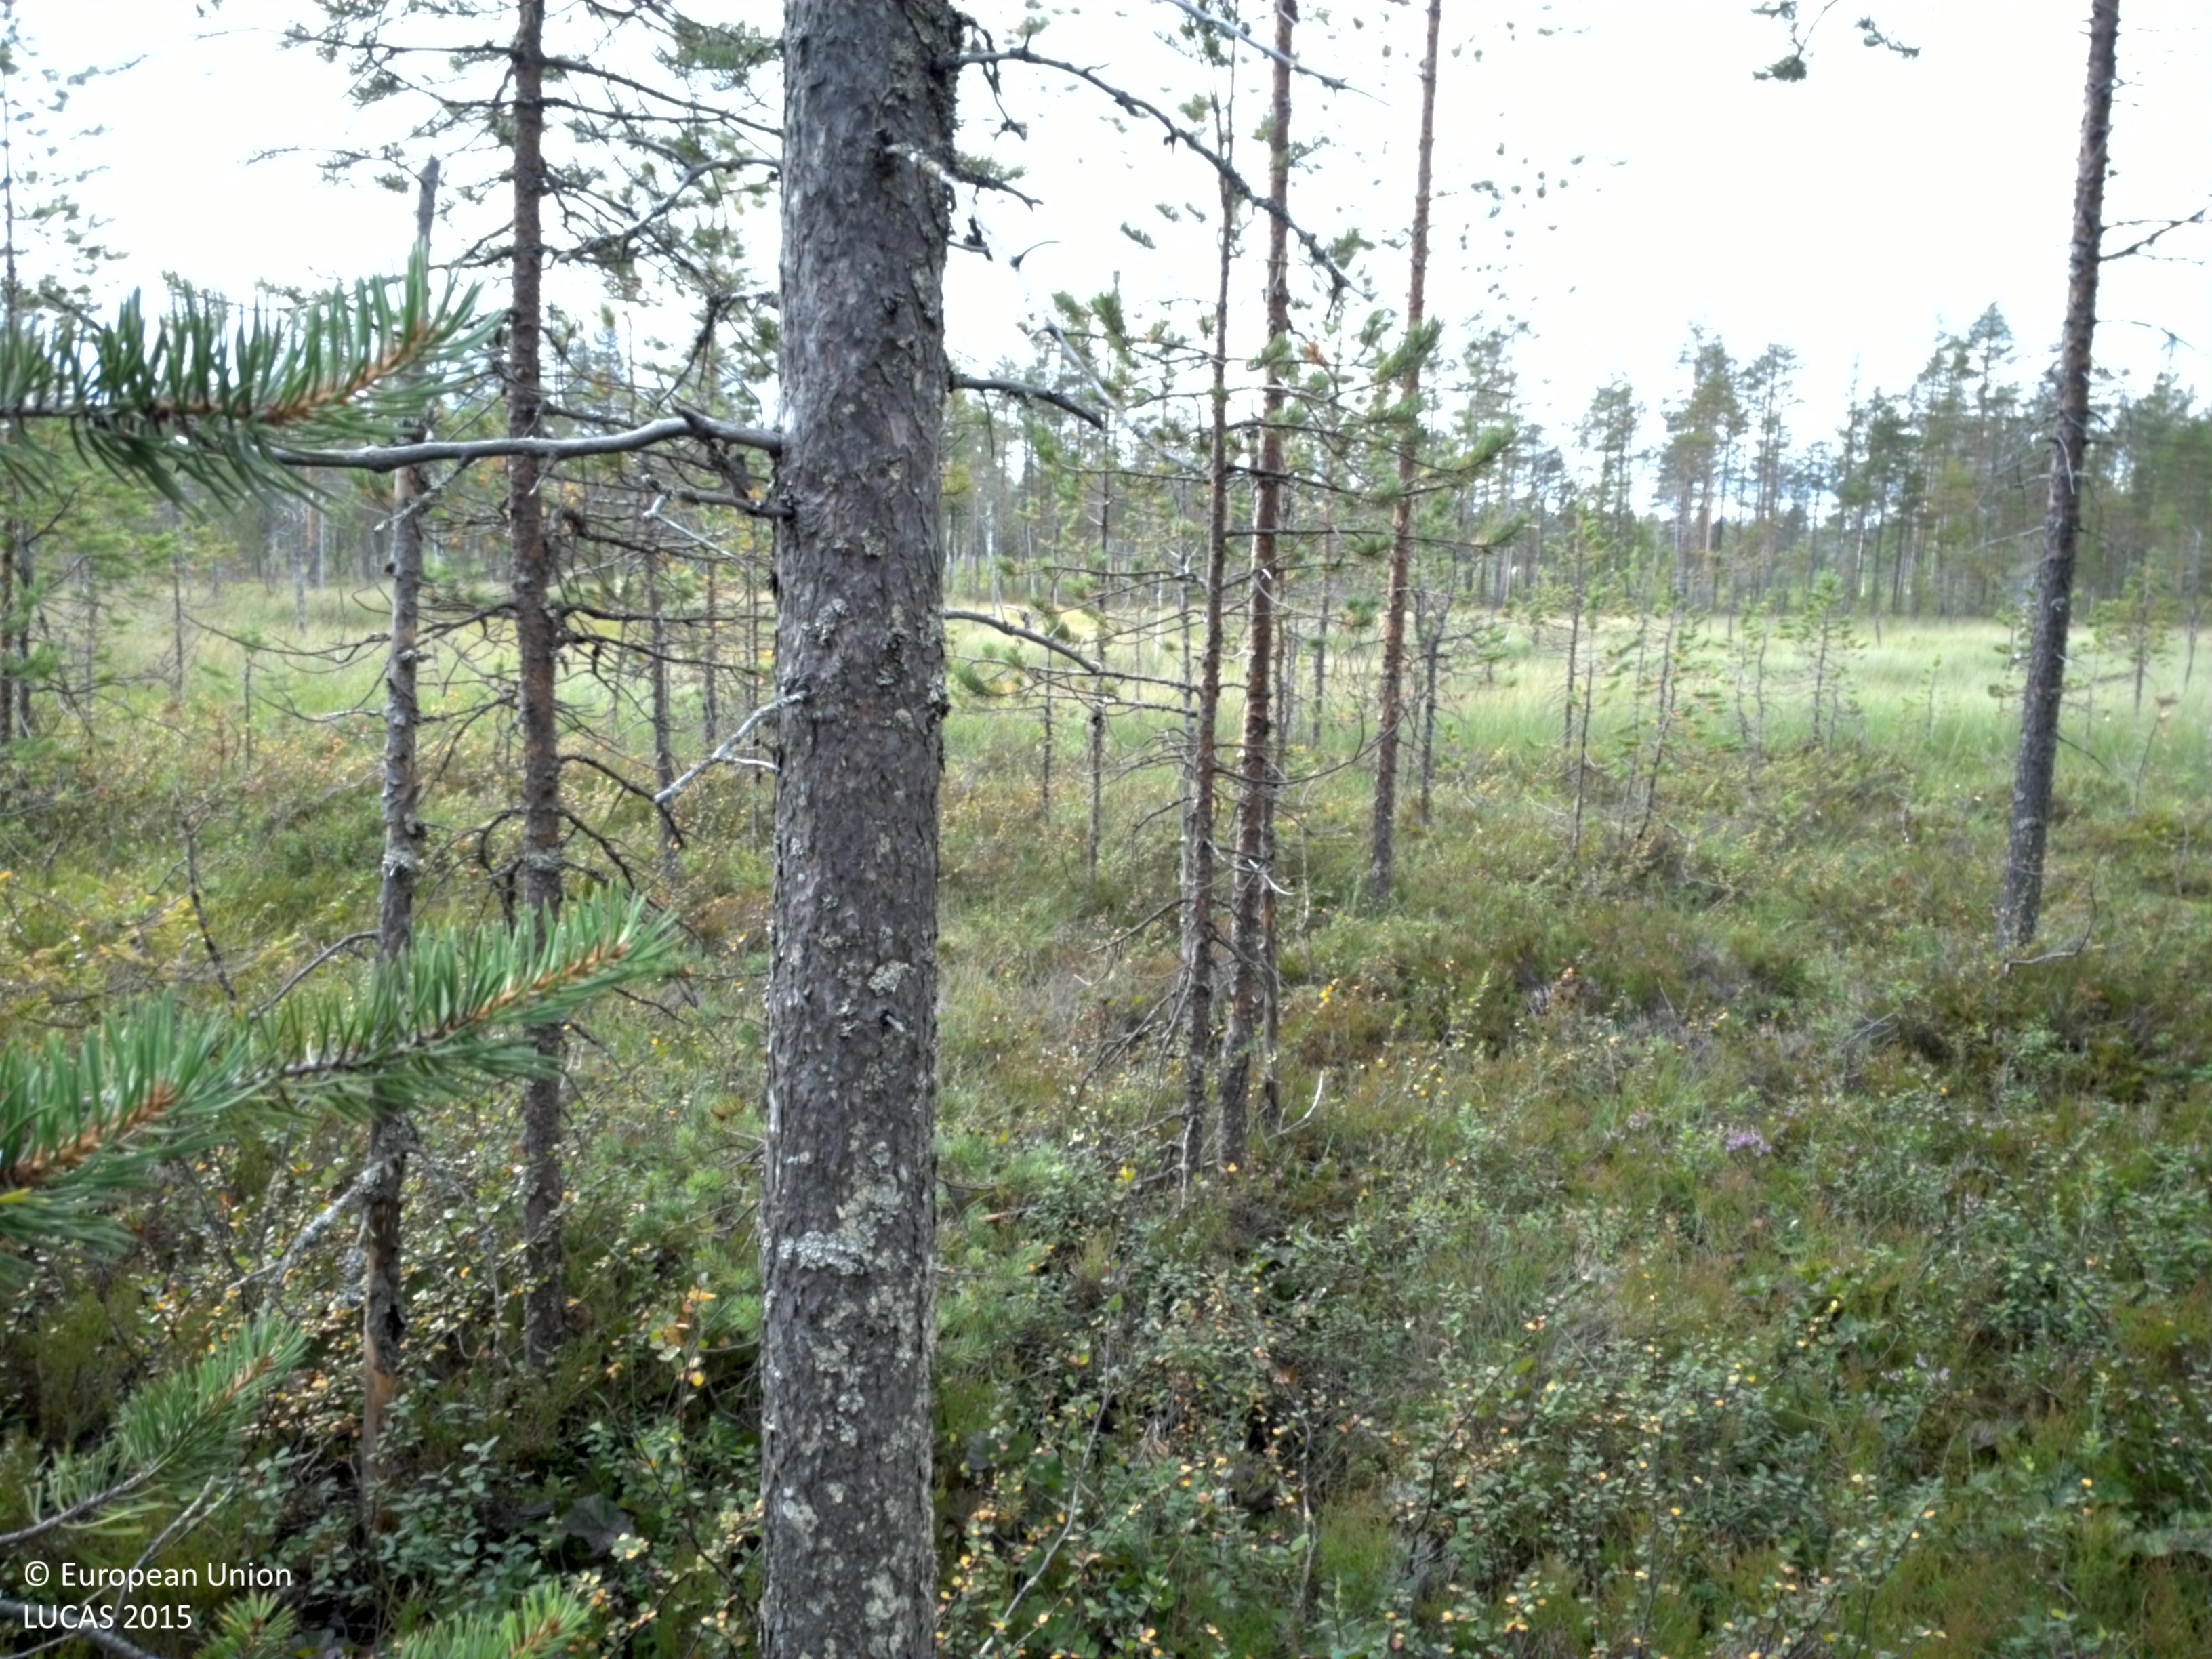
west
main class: Woodland
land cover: Pine dominated coniferous woodland
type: boreal forest
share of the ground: 25 - 50 %
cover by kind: shrubs 70 %, coniferous forest trees 25 %, lichens and mosses 5 %
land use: Forestry
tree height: > 5 m
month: August
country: SE
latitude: 65.9927
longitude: 22.5118
